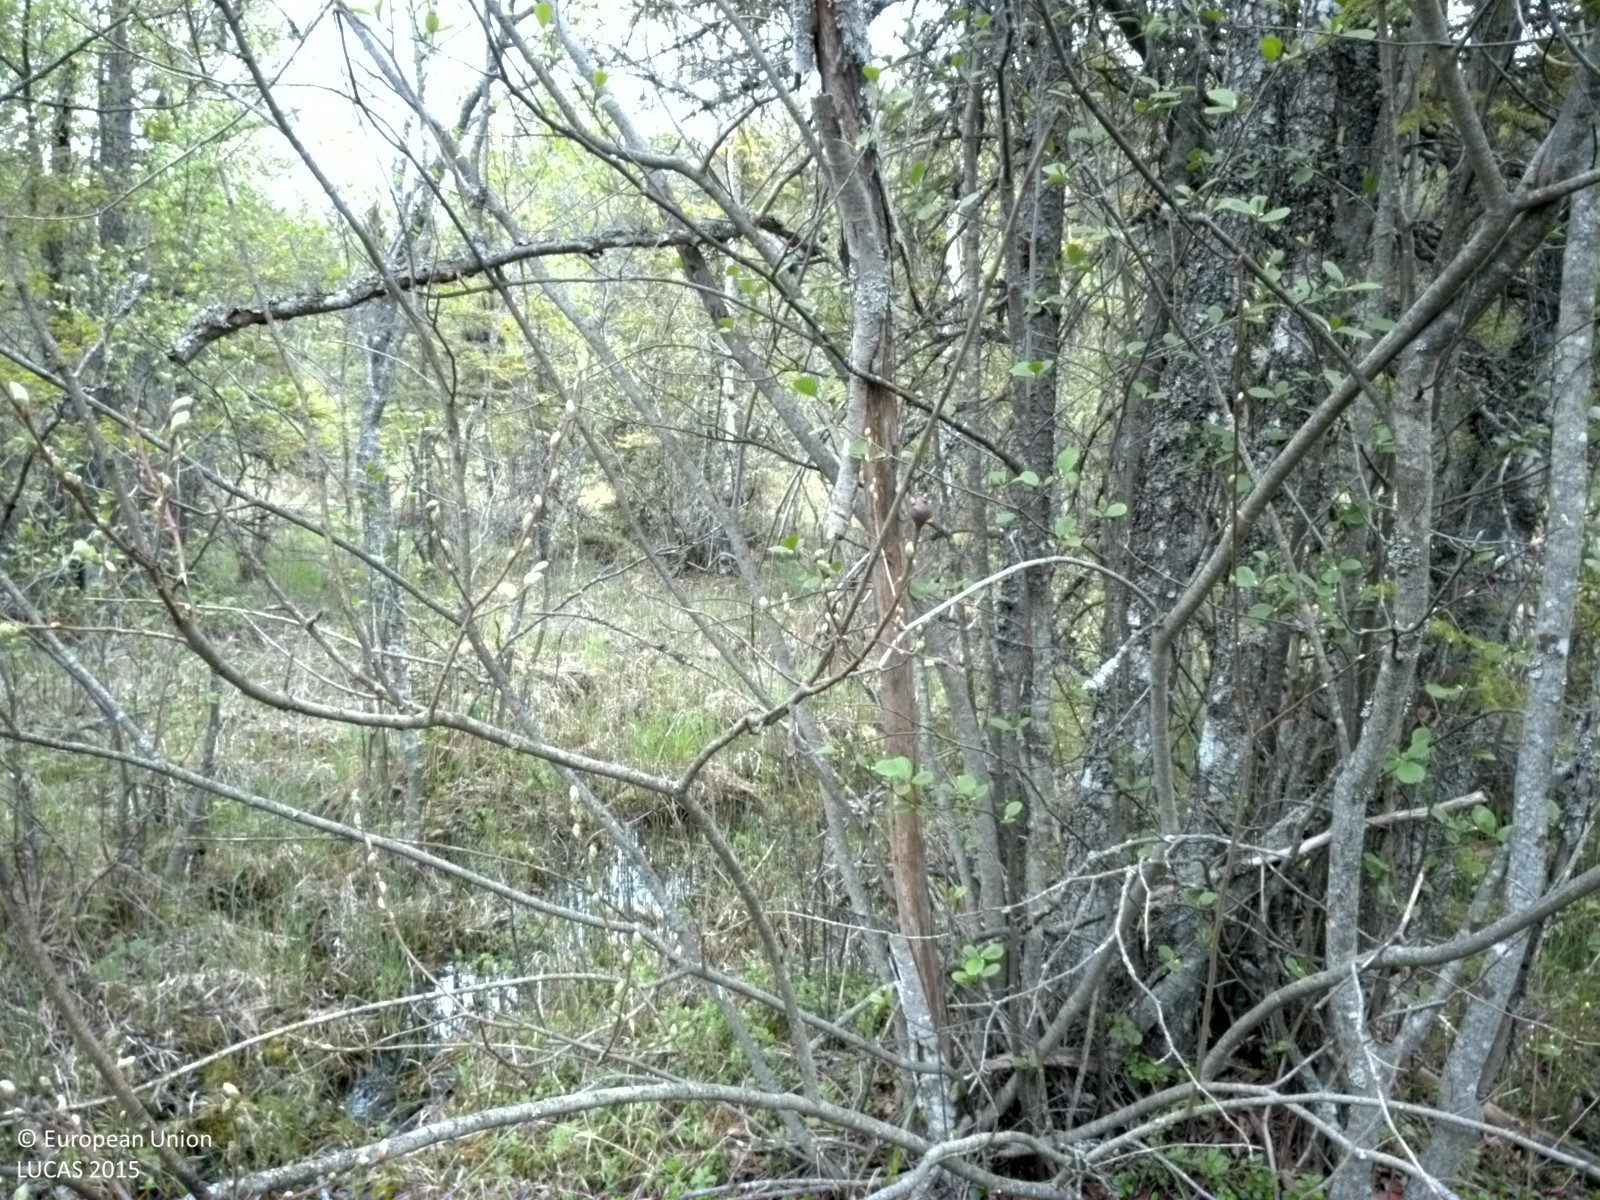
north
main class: Woodland
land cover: Spruce dominated mixed woodland
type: boreal forest
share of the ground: > 75 %
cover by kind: coniferous forest trees 40 %, broadleaved forest trees 40 %, herbaceous plants 15 %, shrubs 5 %
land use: Forestry
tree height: > 5 m
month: May
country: SE
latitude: 60.2928
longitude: 18.0804
